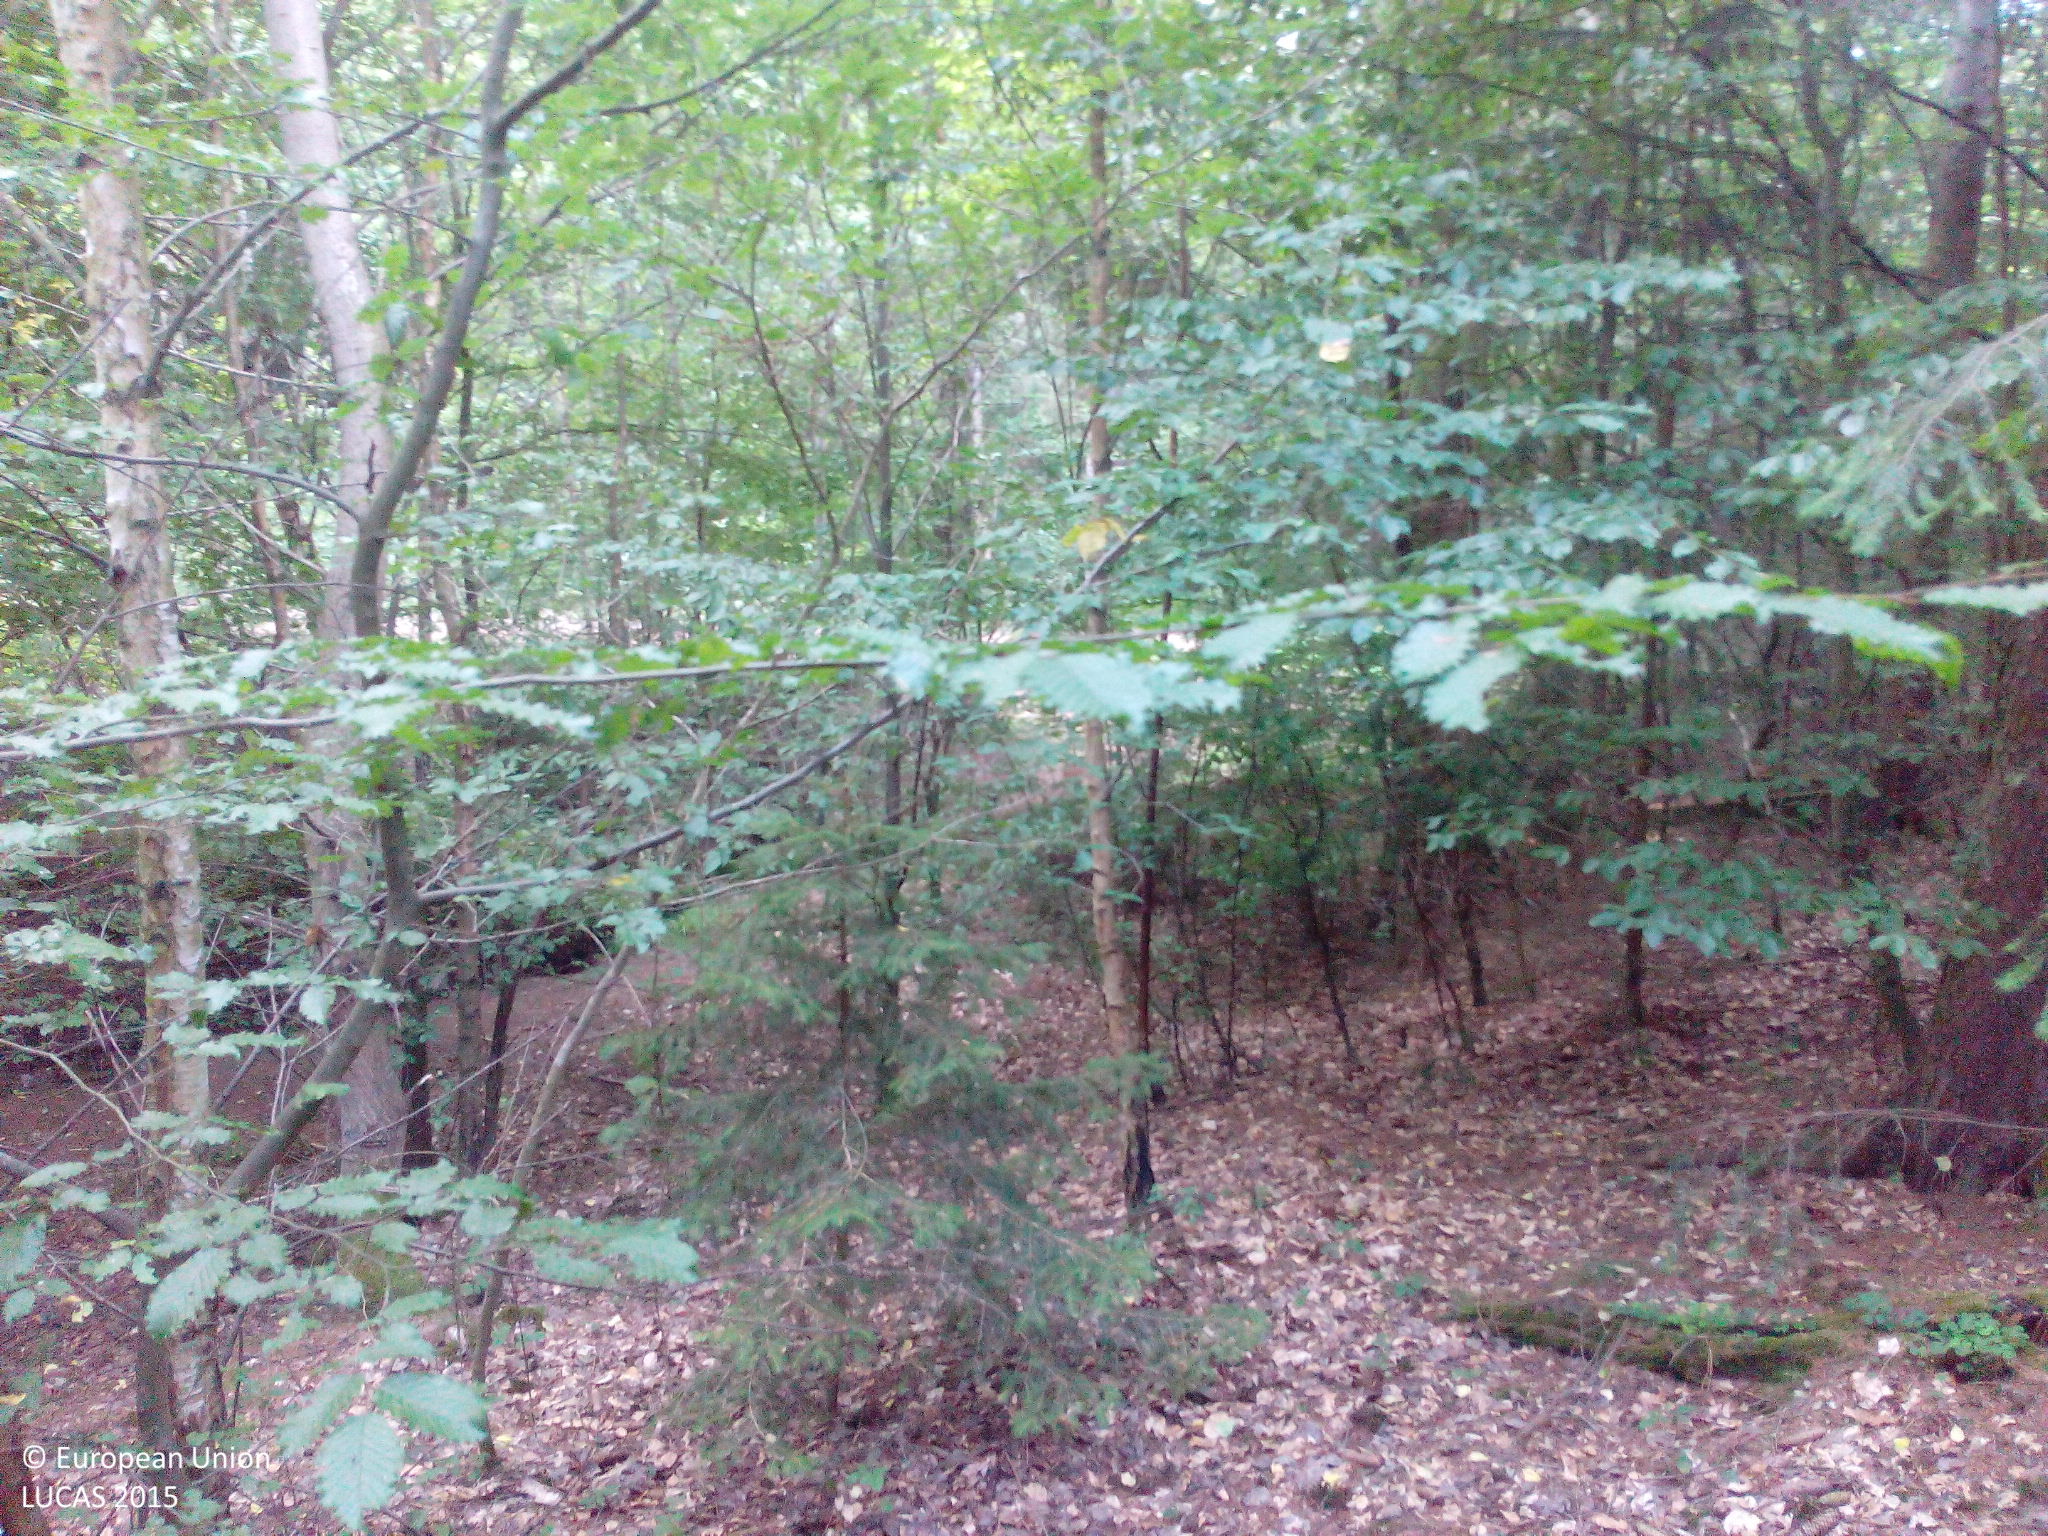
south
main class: Woodland
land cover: Spruce dominated mixed woodland
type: mesophytic deciduous forest
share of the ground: > 75 %
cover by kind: coniferous forest trees 50 %, broadleaved forest trees 25 %, herbaceous plants 10 %, lichens and mosses 10 %, unconsolidated bare surface 5 %
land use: Forestry
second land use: Amenities, museums, leisure
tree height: > 5 m
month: August
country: DE
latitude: 50.2119
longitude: 7.5480
